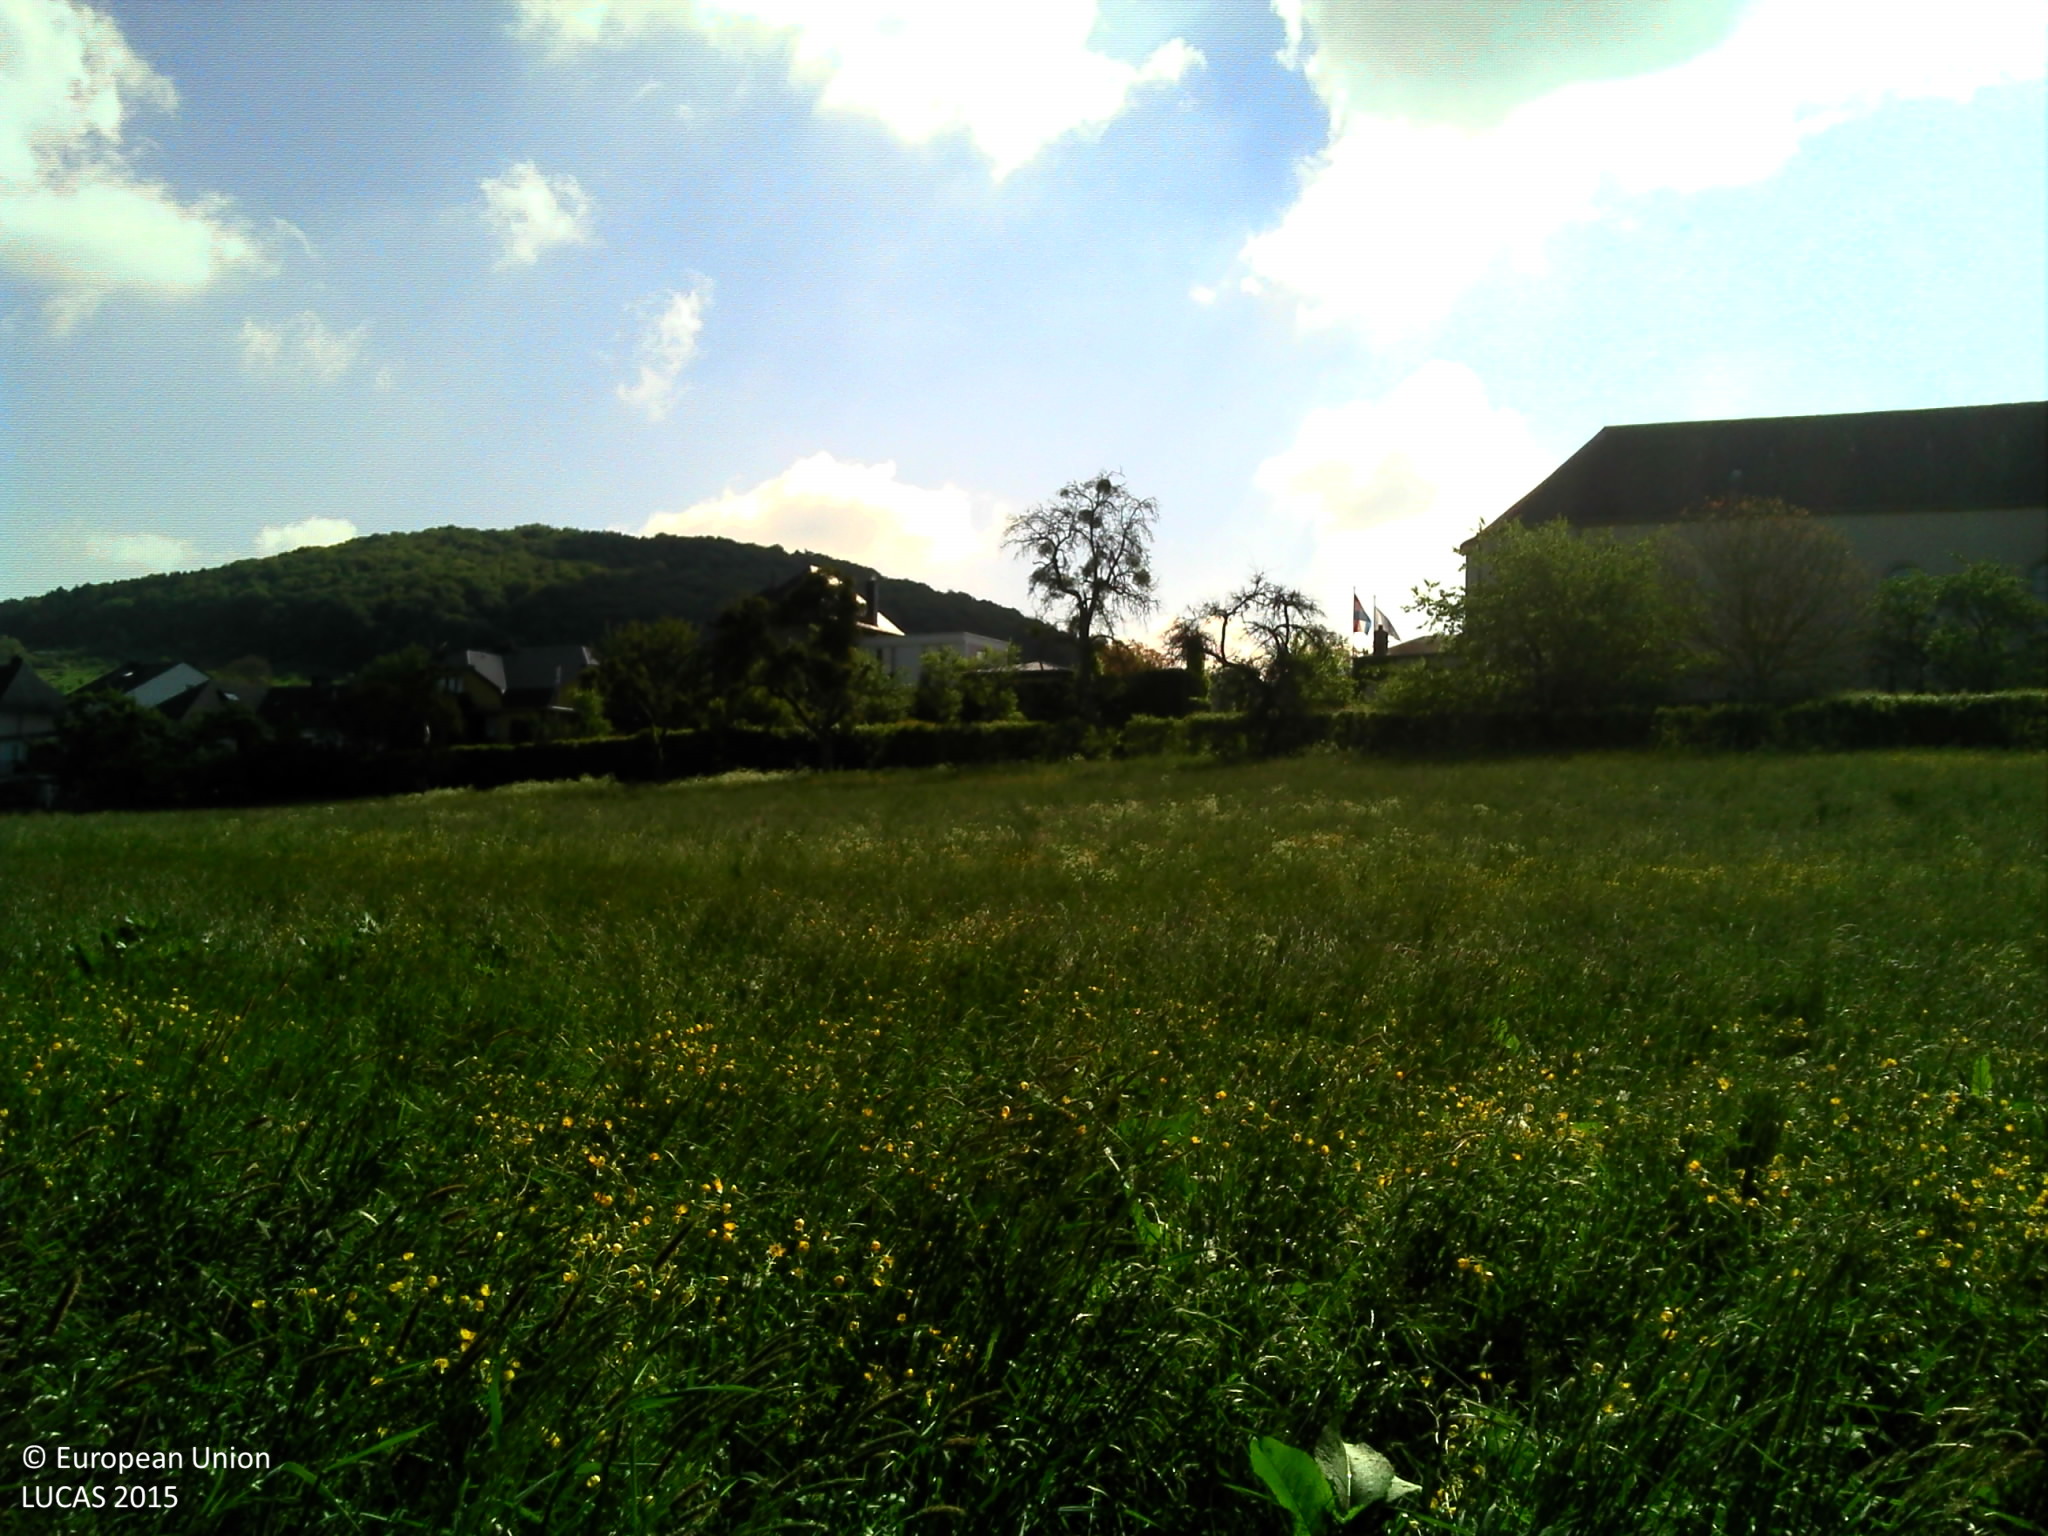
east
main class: Woodland
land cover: Broadleaved woodland
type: floodplain forest
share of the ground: > 75 %
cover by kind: broadleaved forest trees 80 %, herbaceous plants 15 %, shrubs 5 %
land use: Agriculture (excluding fallow land and kitchen gardens)
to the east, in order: Grassland without tree/shrub cover; Fences; Managed hedges; Artificial constructions in urban areas
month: May
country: LU
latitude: 49.6562
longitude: 6.3010
